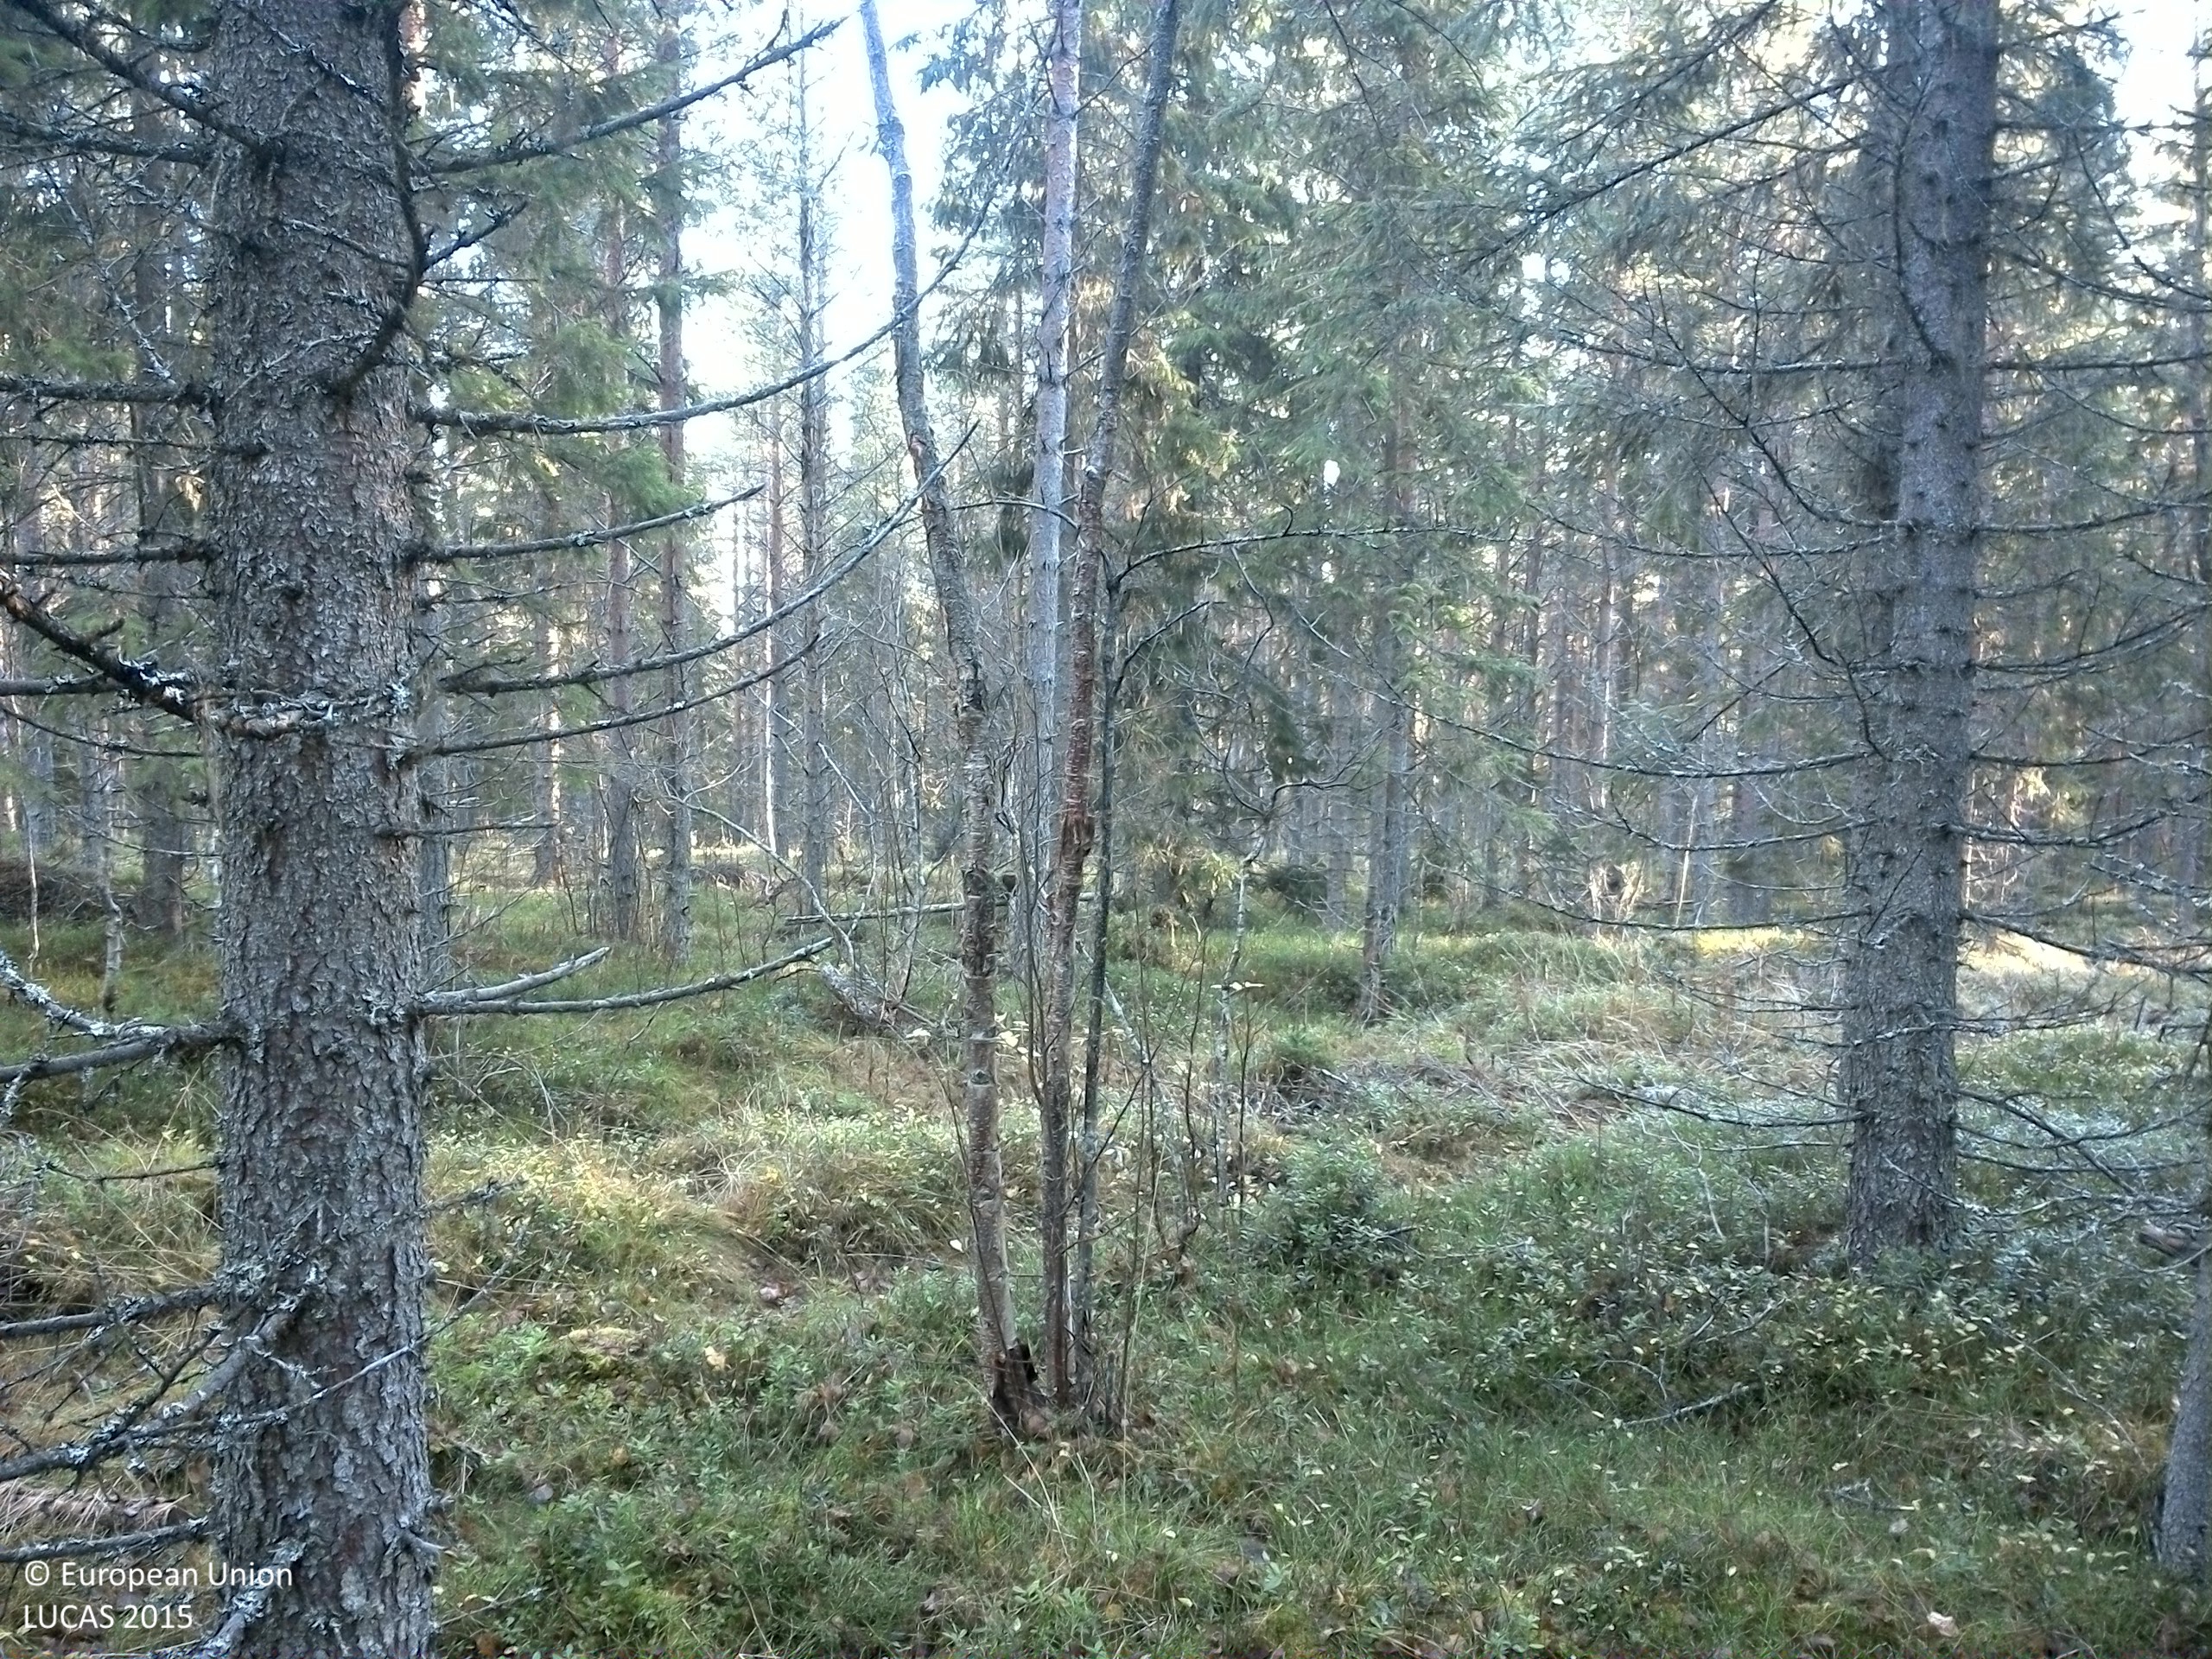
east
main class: Woodland
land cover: Pine dominated coniferous woodland
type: boreal forest
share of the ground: 50 - 75 %
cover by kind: coniferous forest trees 55 %, shrubs 25 %, lichens and mosses 15 %, herbaceous plants 5 %
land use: Forestry
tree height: > 5 m
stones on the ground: 25 - 50 %
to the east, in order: Pine dominated coniferous woodland; Broadleaved woodland; Ditches and canals; Broadleaved woodland; Paved roads, cycling and walking lanes; Broadleaved woodland; Spruce dominated coniferous woodland; Other coniferous woodland
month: October
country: SE
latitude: 63.7329
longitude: 15.7455
